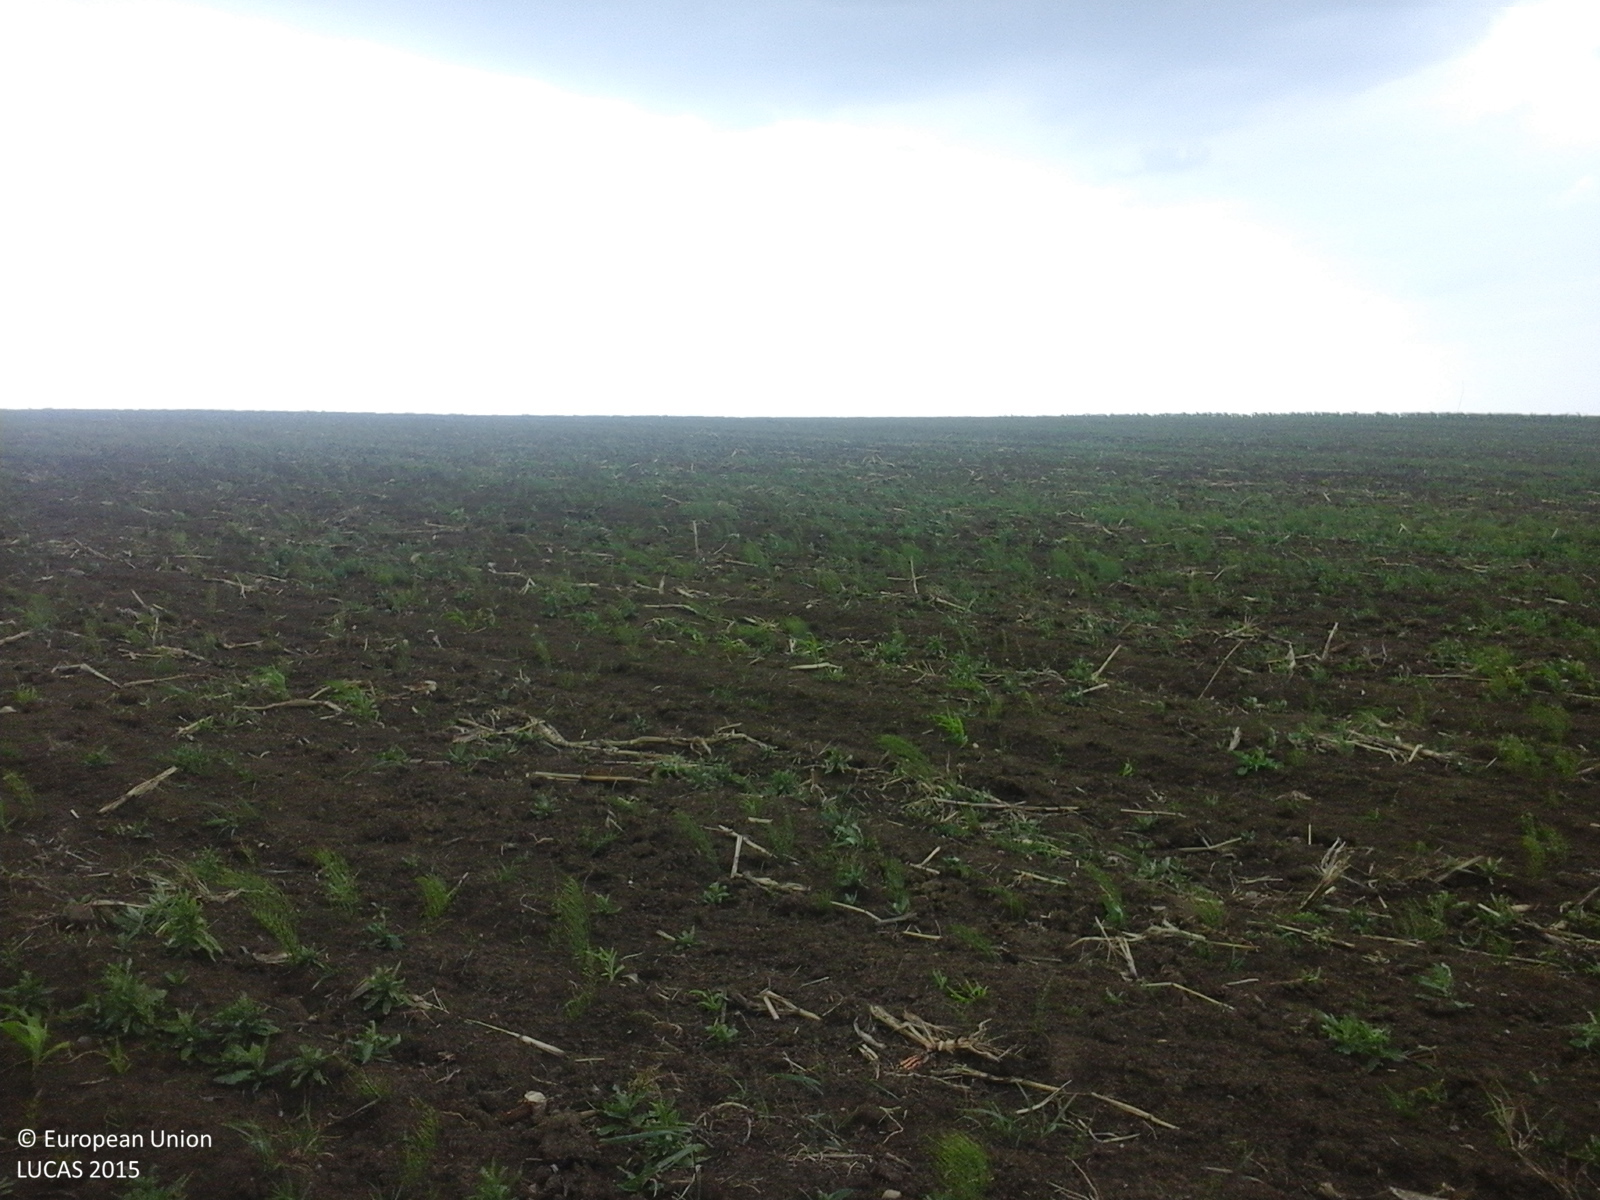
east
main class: Cropland
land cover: Maize
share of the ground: < 10 %
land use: Agriculture (excluding fallow land and kitchen gardens)
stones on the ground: < 10 %
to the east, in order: Maize; Oats; Grassland without tree/shrub cover; Maize
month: June
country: RO
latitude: 47.3168
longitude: 26.5055
